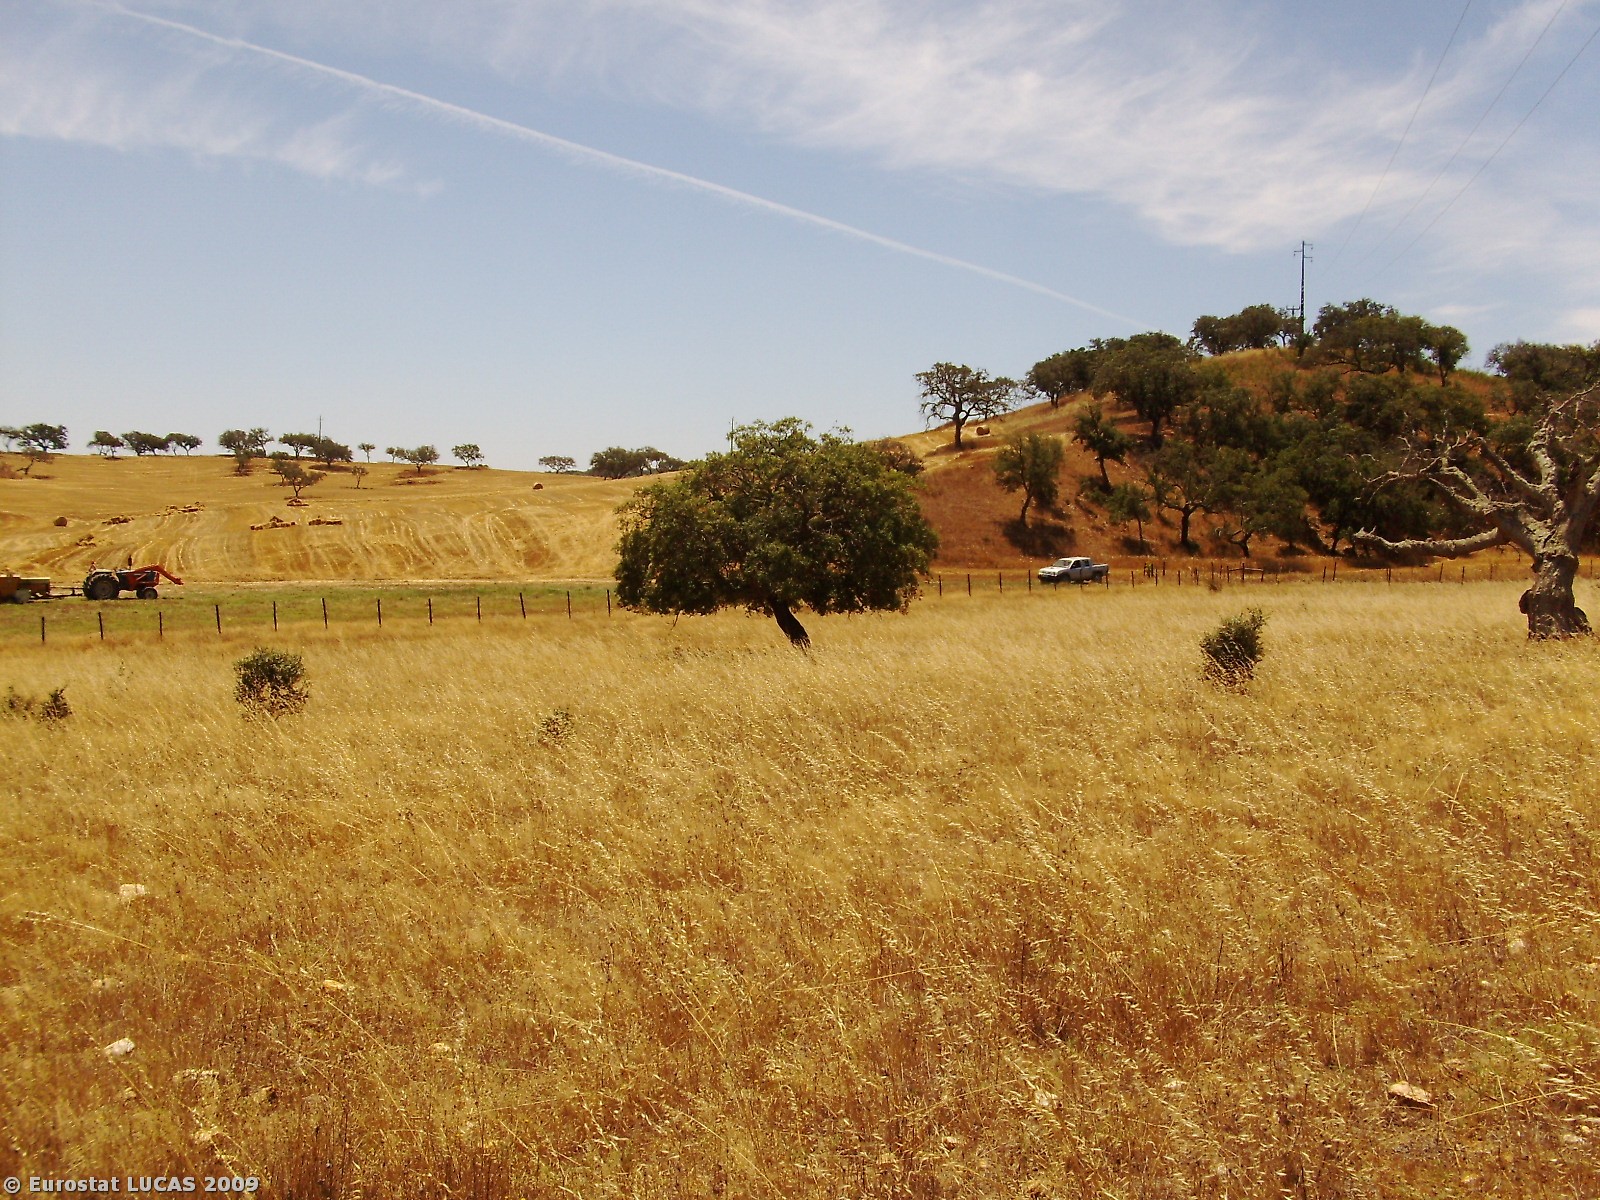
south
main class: Grassland
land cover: Grassland with sparse tree/shrub cover
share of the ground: > 75 %
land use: Agriculture (excluding fallow land and kitchen gardens)
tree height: > 5 m
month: July
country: PT
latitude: 37.7535
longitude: -8.3880
